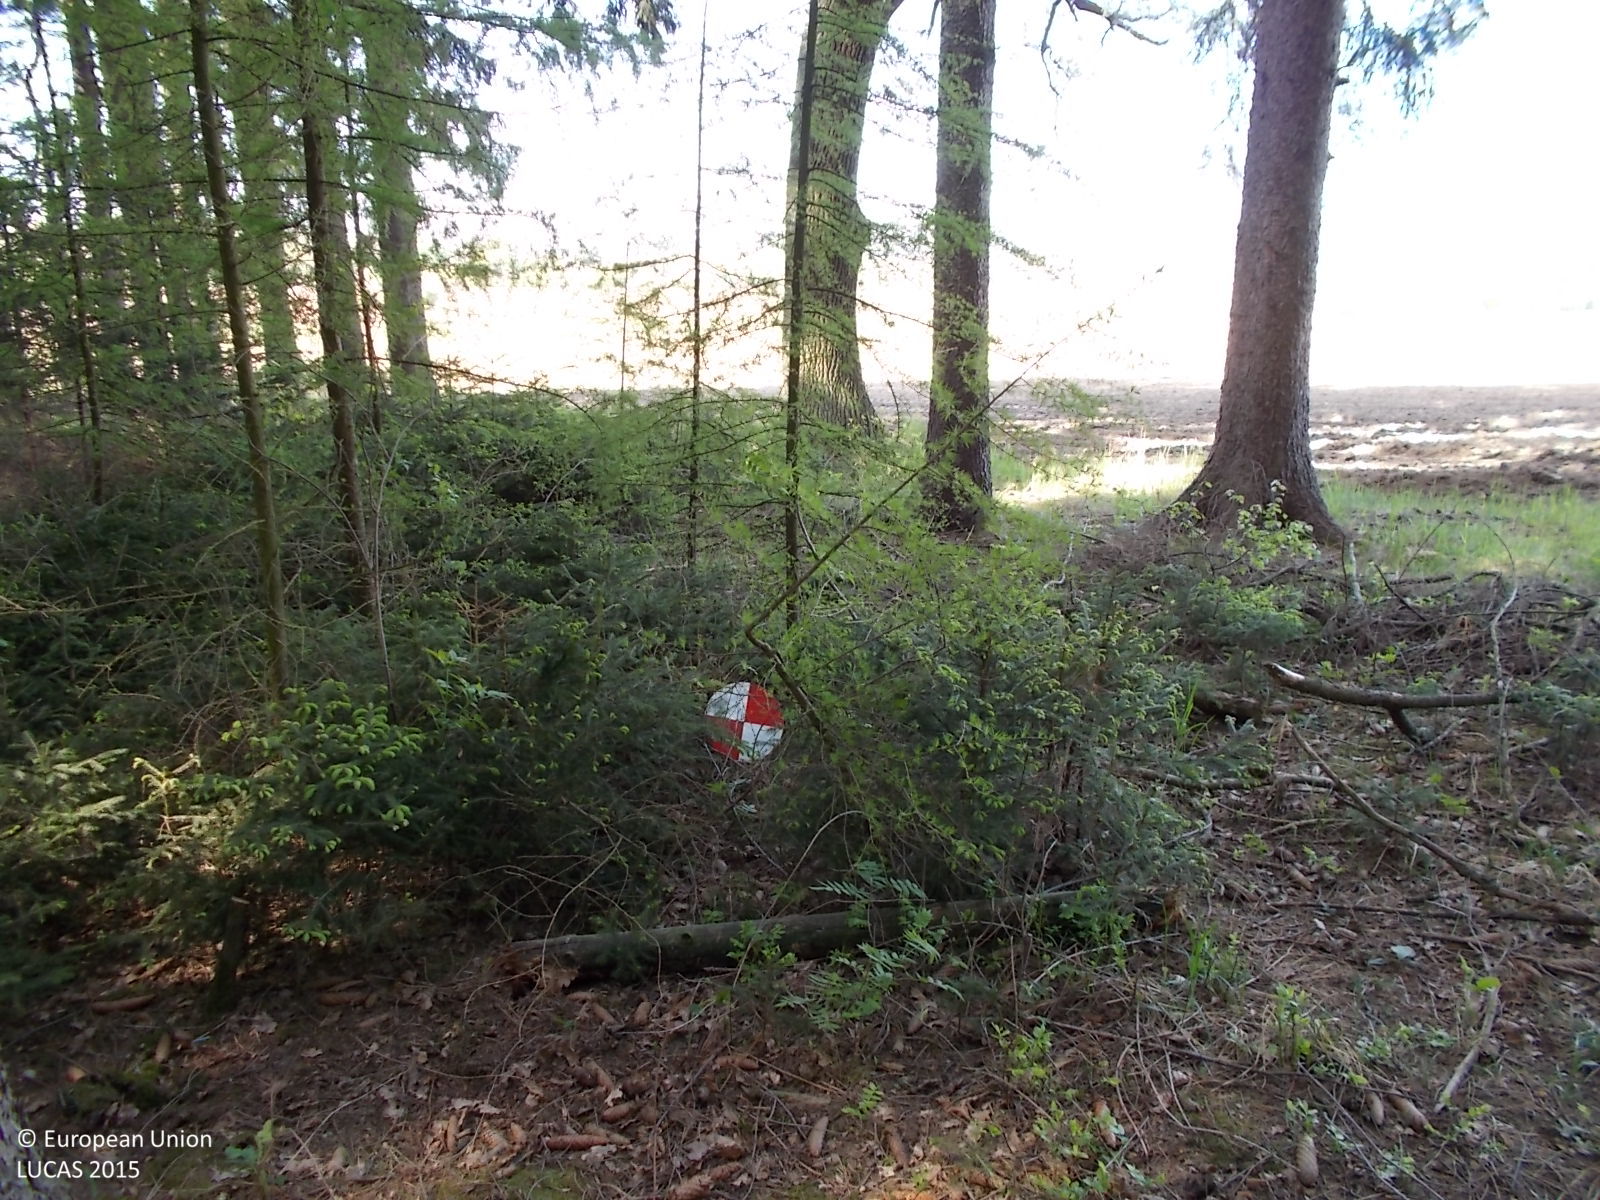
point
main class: Woodland
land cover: Spruce dominated coniferous woodland
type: hemiboreal forest and nemoral coniferous forest and mixed broadleaved-coniferous forest
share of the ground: > 75 %
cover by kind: coniferous forest trees 80 %, herbaceous plants 10 %, shrubs 5 %, lichens and mosses 5 %
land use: Forestry
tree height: > 5 m
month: May
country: CZ
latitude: 49.5405
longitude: 15.6286
